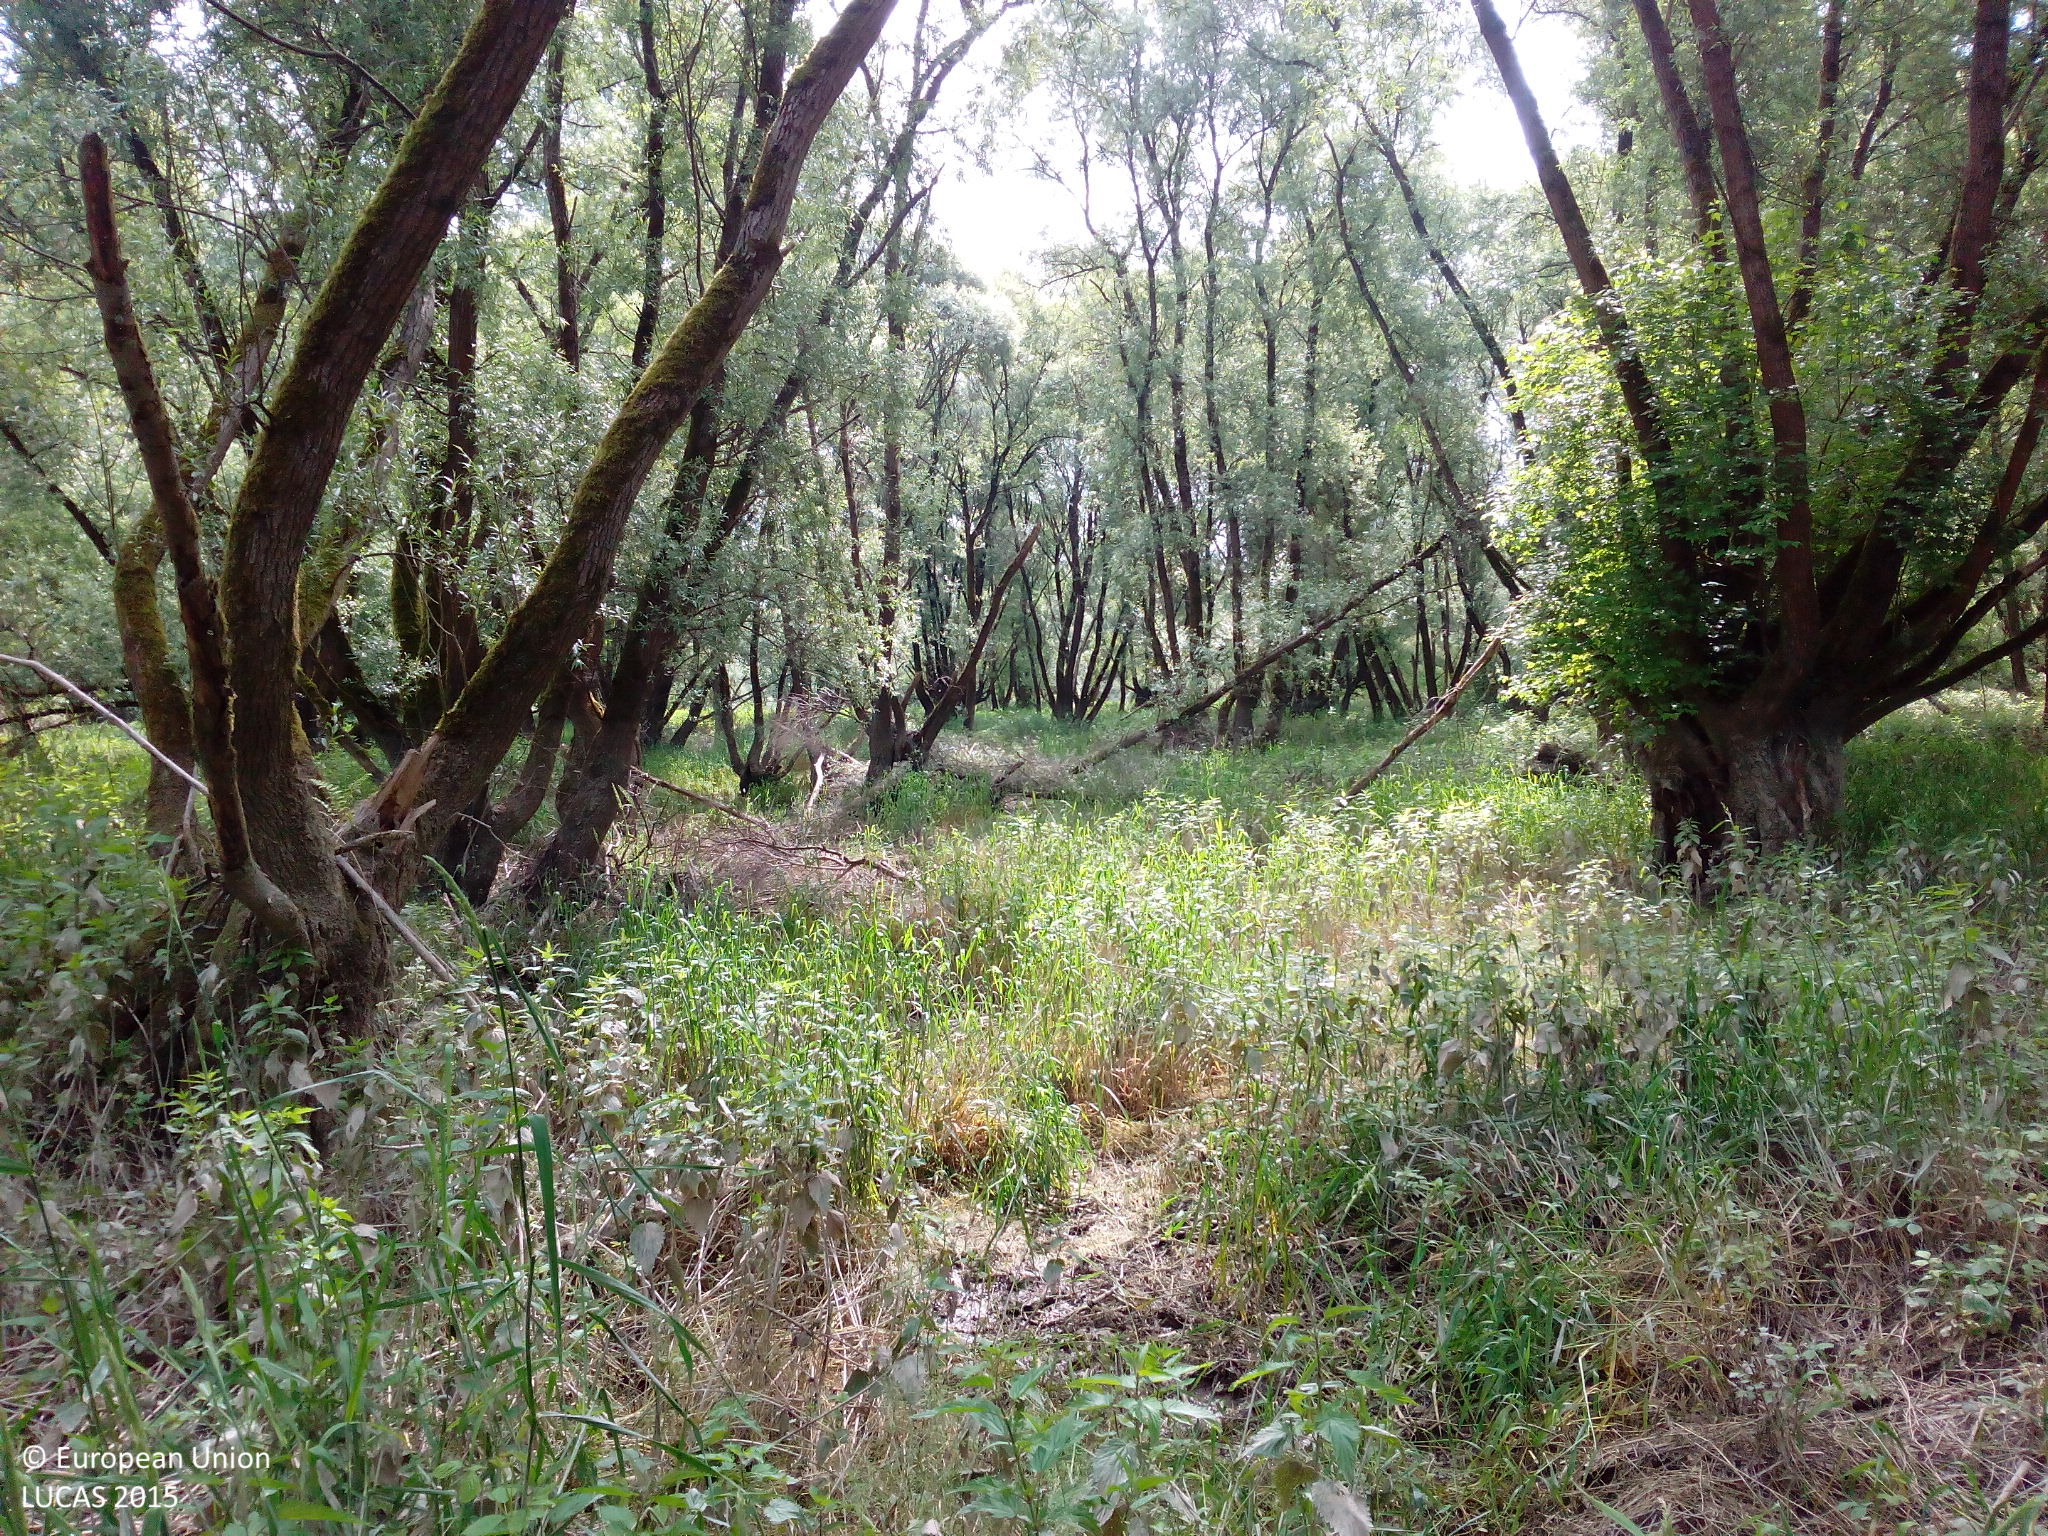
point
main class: Woodland
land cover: Broadleaved woodland
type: floodplain forest
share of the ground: 25 - 50 %
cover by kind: broadleaved forest trees 60 %, herbaceous plants 20 %, unconsolidated bare surface 20 %
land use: Semi-natural and natural areas not in use
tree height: > 5 m
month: May
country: DE
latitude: 48.9100
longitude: 8.1587
